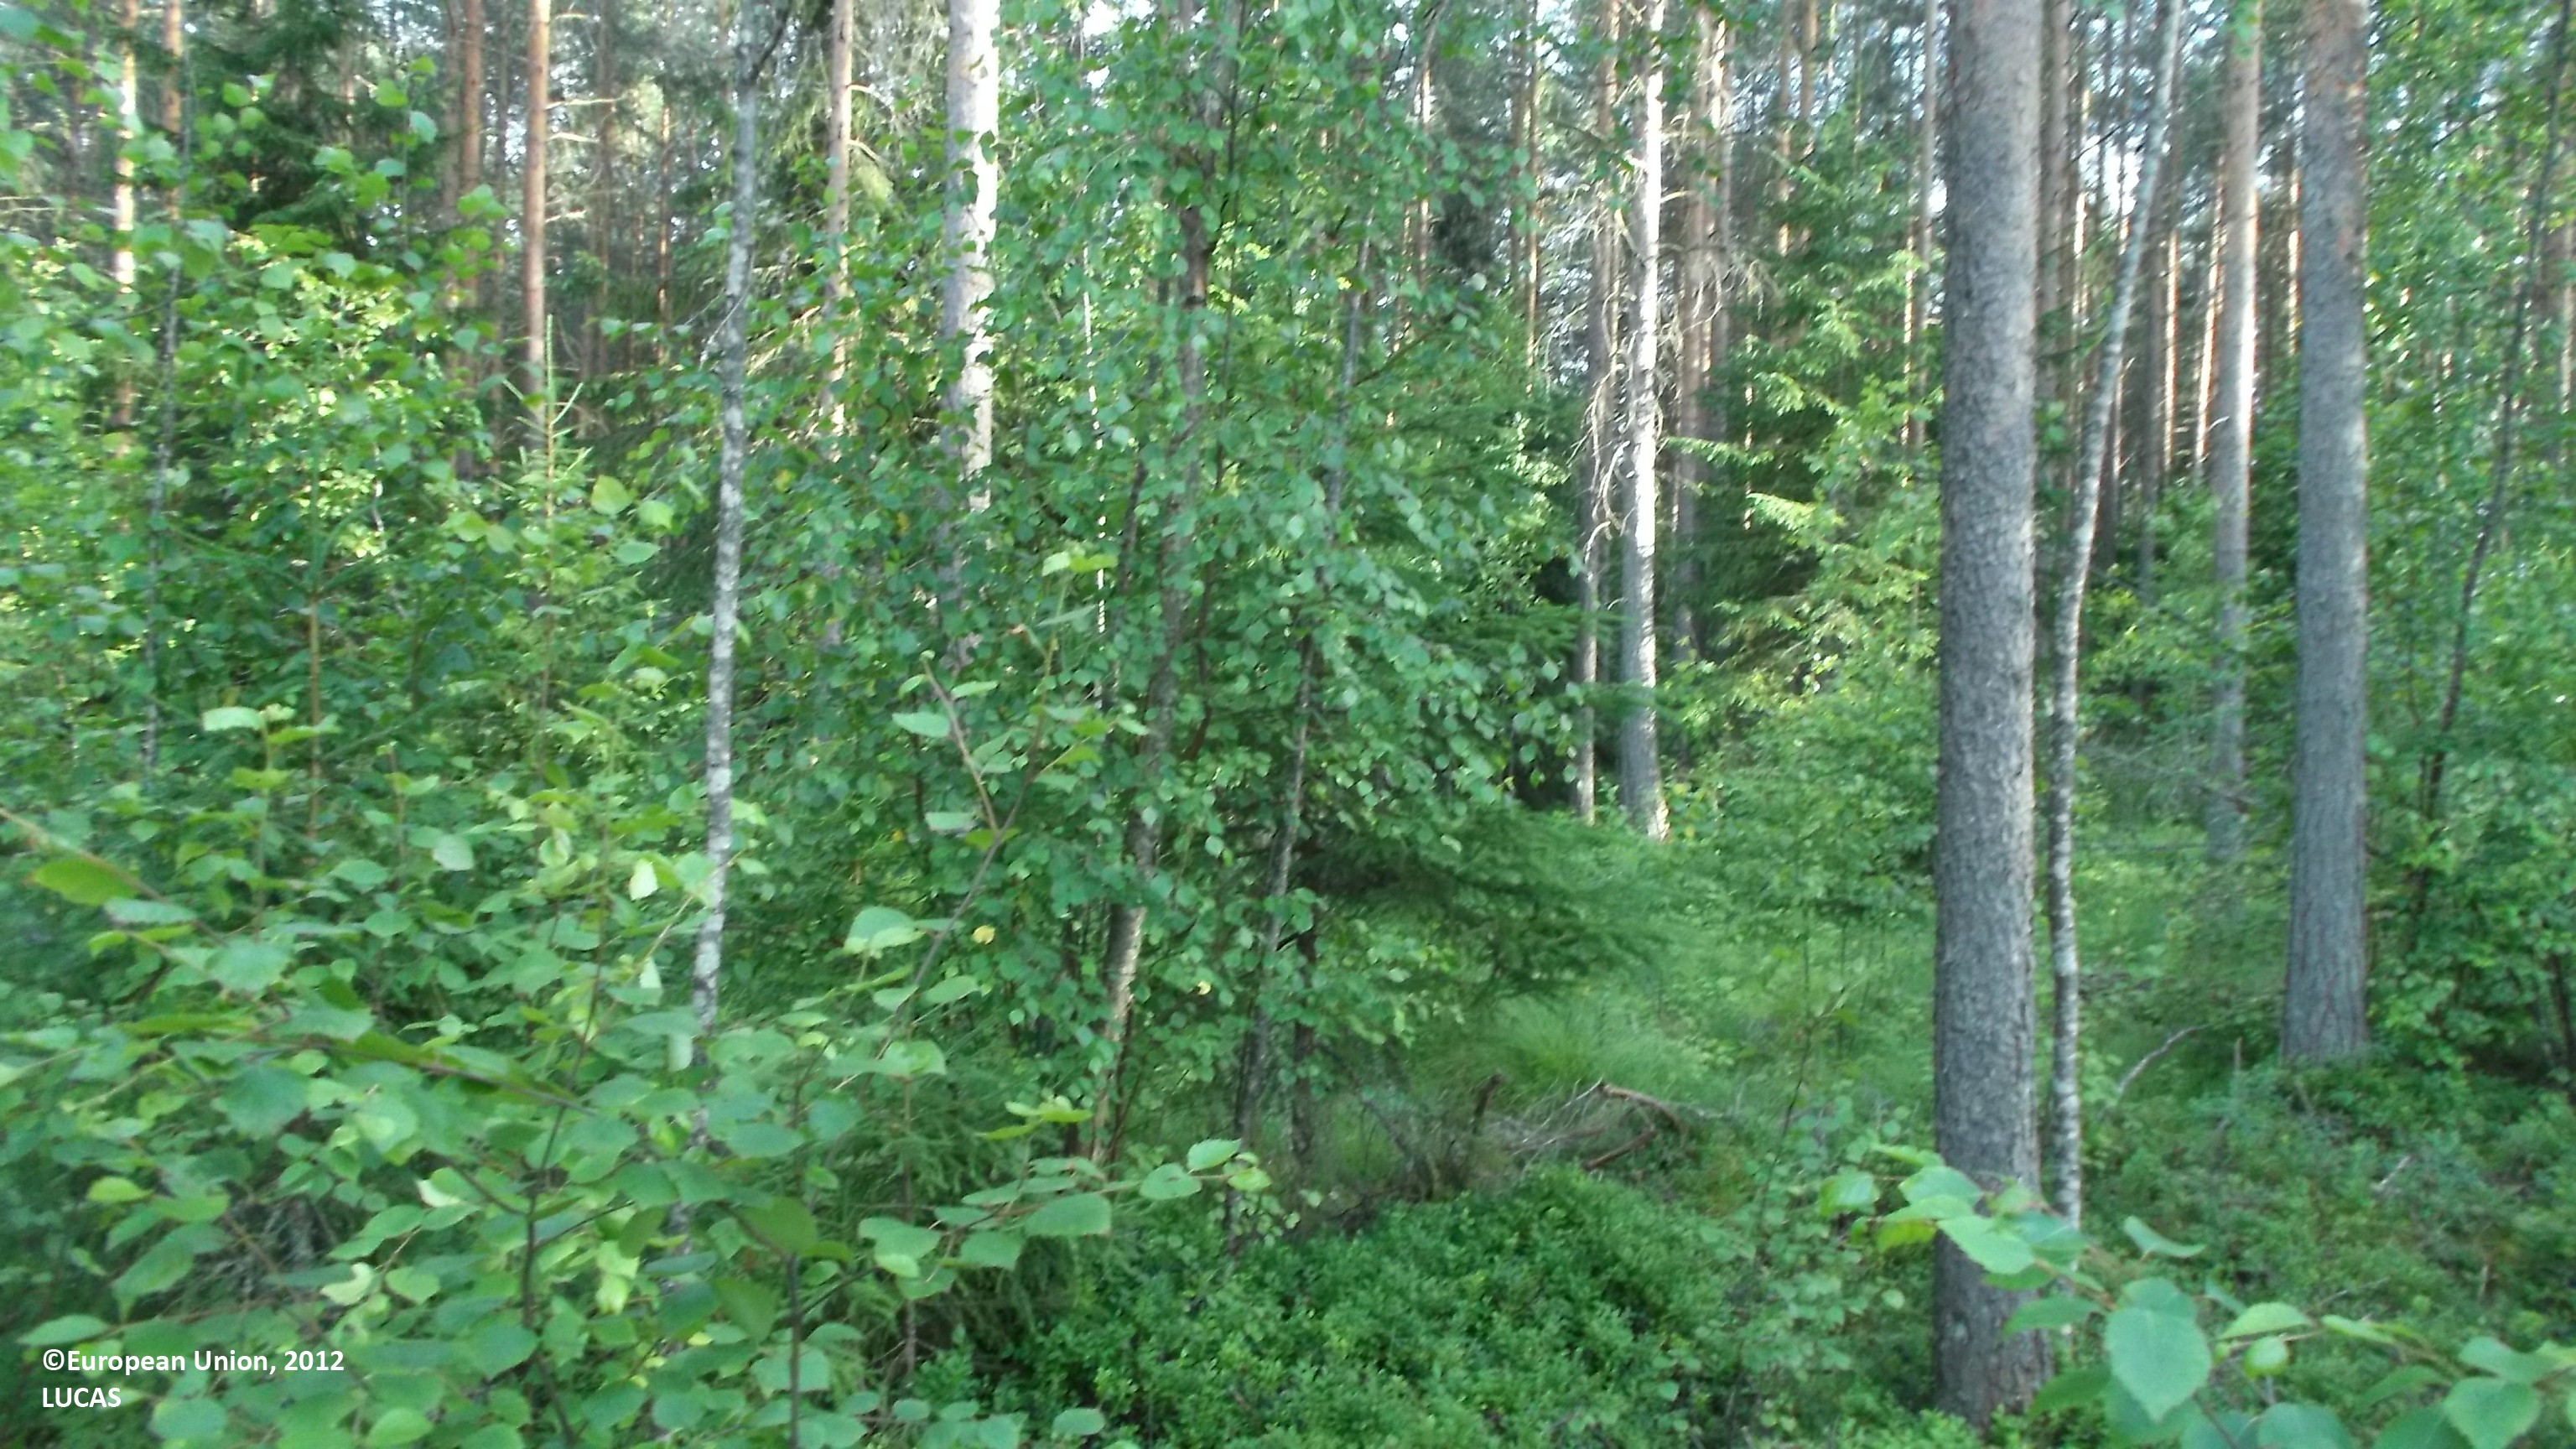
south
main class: Woodland
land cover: Other coniferous woodland
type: boreal forest
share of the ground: 25 - 50 %
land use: Forestry
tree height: > 5 m
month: July
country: FI
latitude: 63.2026
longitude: 23.8081
